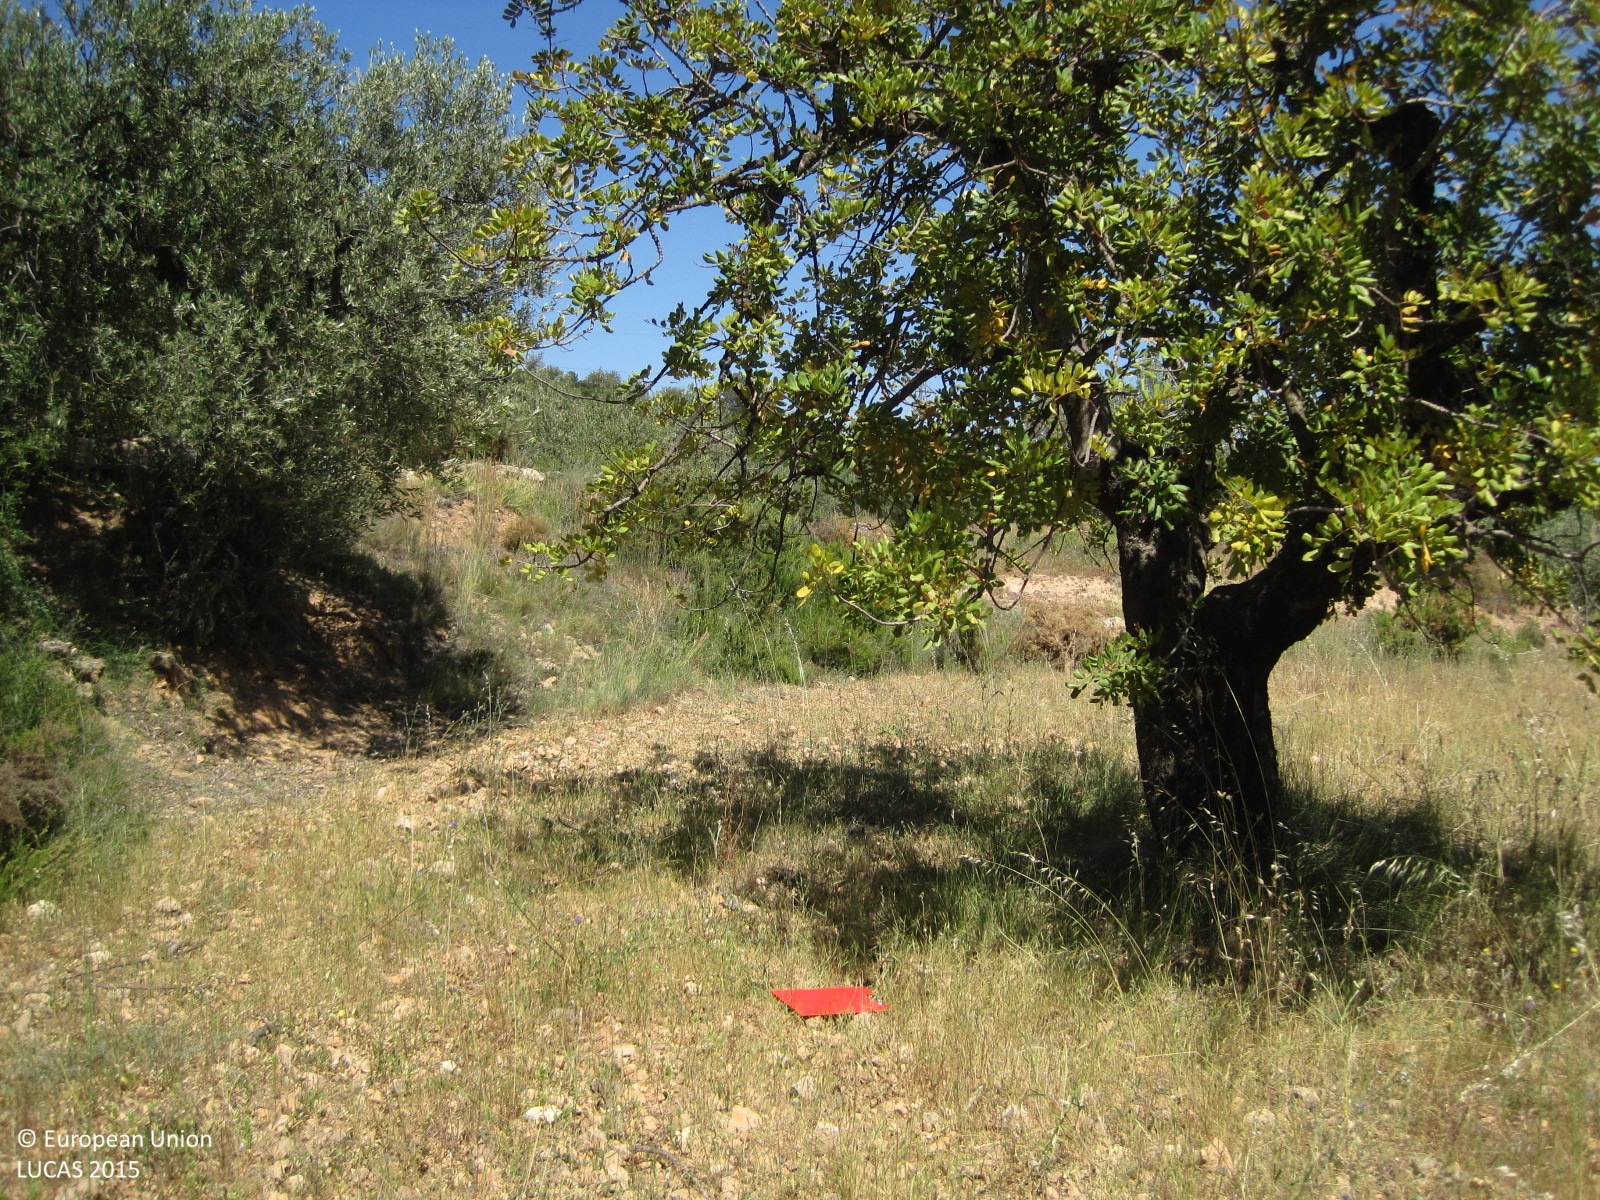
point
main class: Cropland
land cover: Permanent industrial crops
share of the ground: 10 - 25 %
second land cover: Spontaneously vegetated surfaces
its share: > 75 %
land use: Agriculture (excluding fallow land and kitchen gardens)
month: May
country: ES
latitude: 39.3768
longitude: -0.8059
